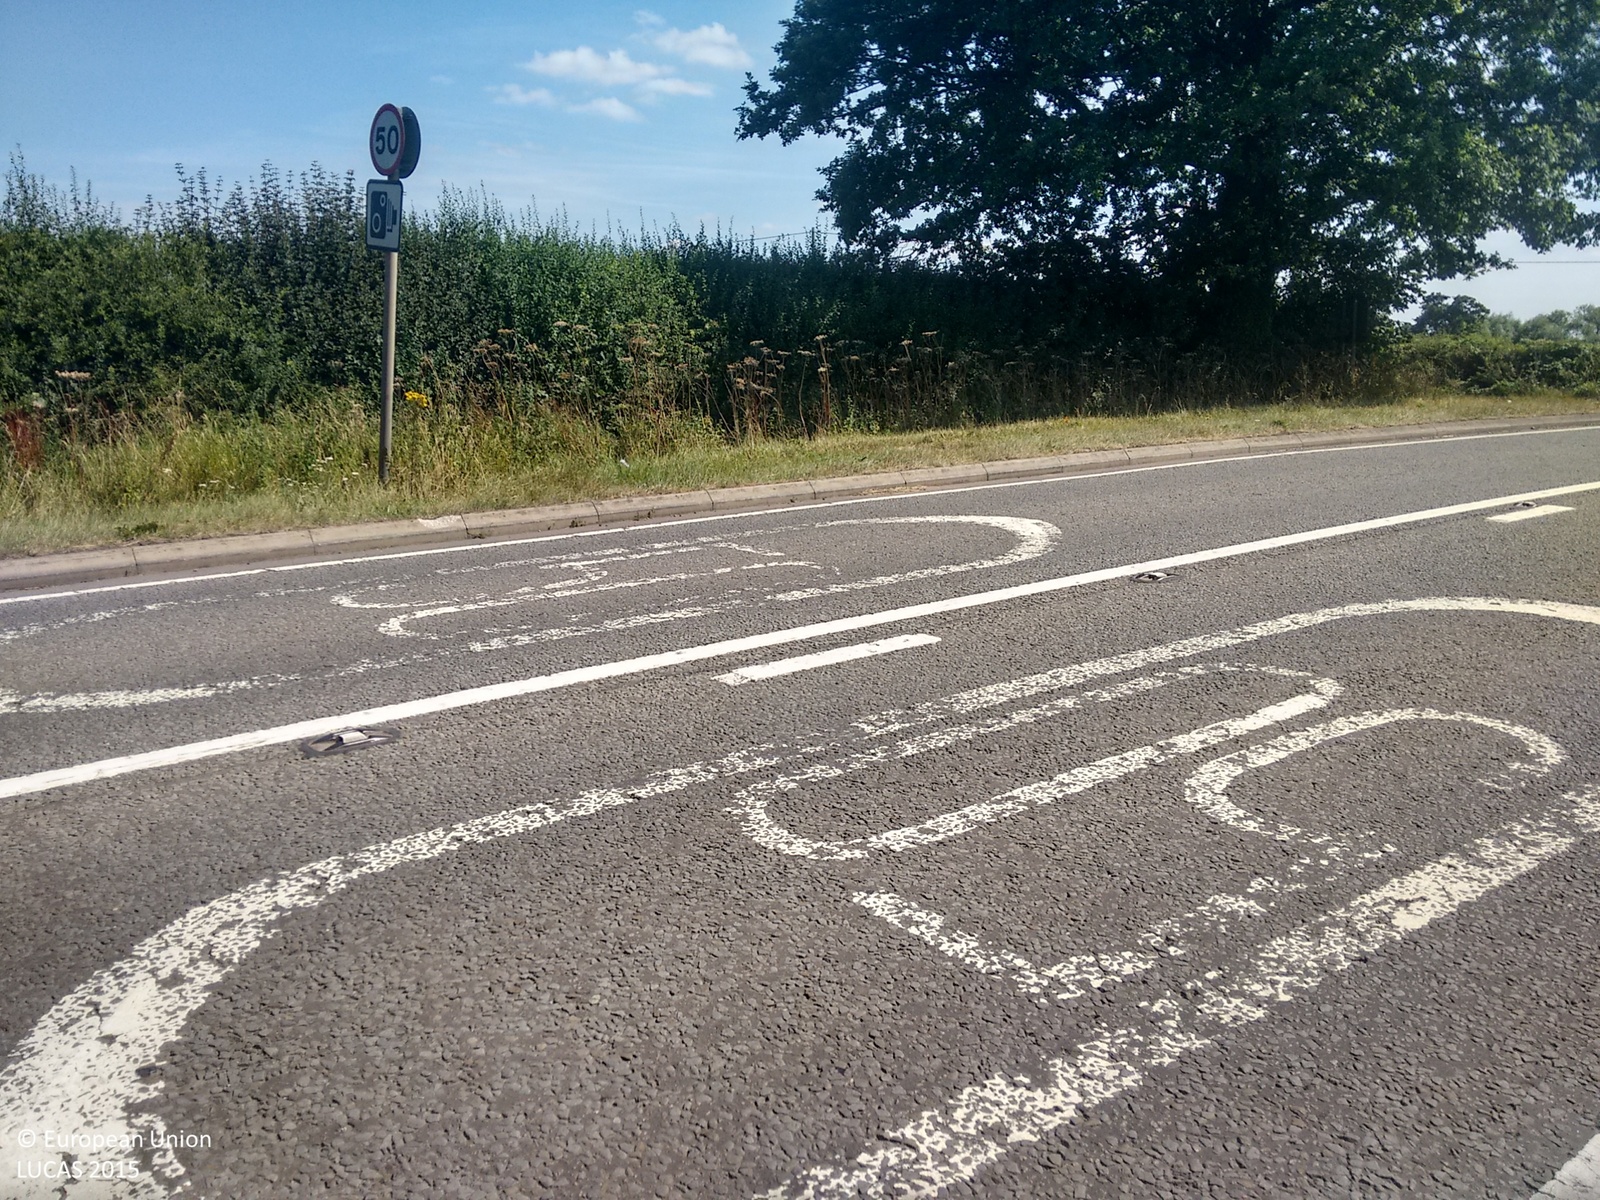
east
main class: Cropland
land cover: Common wheat
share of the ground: > 75 %
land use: Agriculture (excluding fallow land and kitchen gardens)
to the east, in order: Common wheat; Grass margins; Managed hedges; Ditches and canals; Managed hedges; Grass margins; Paved roads, cycling and walking lanes; Grass margins; Ditches and canals; Fences; Grass margins; Rape and turnip rape; Electric lines; Rape and turnip rape
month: August
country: GB
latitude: 52.5629
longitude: -1.4834
